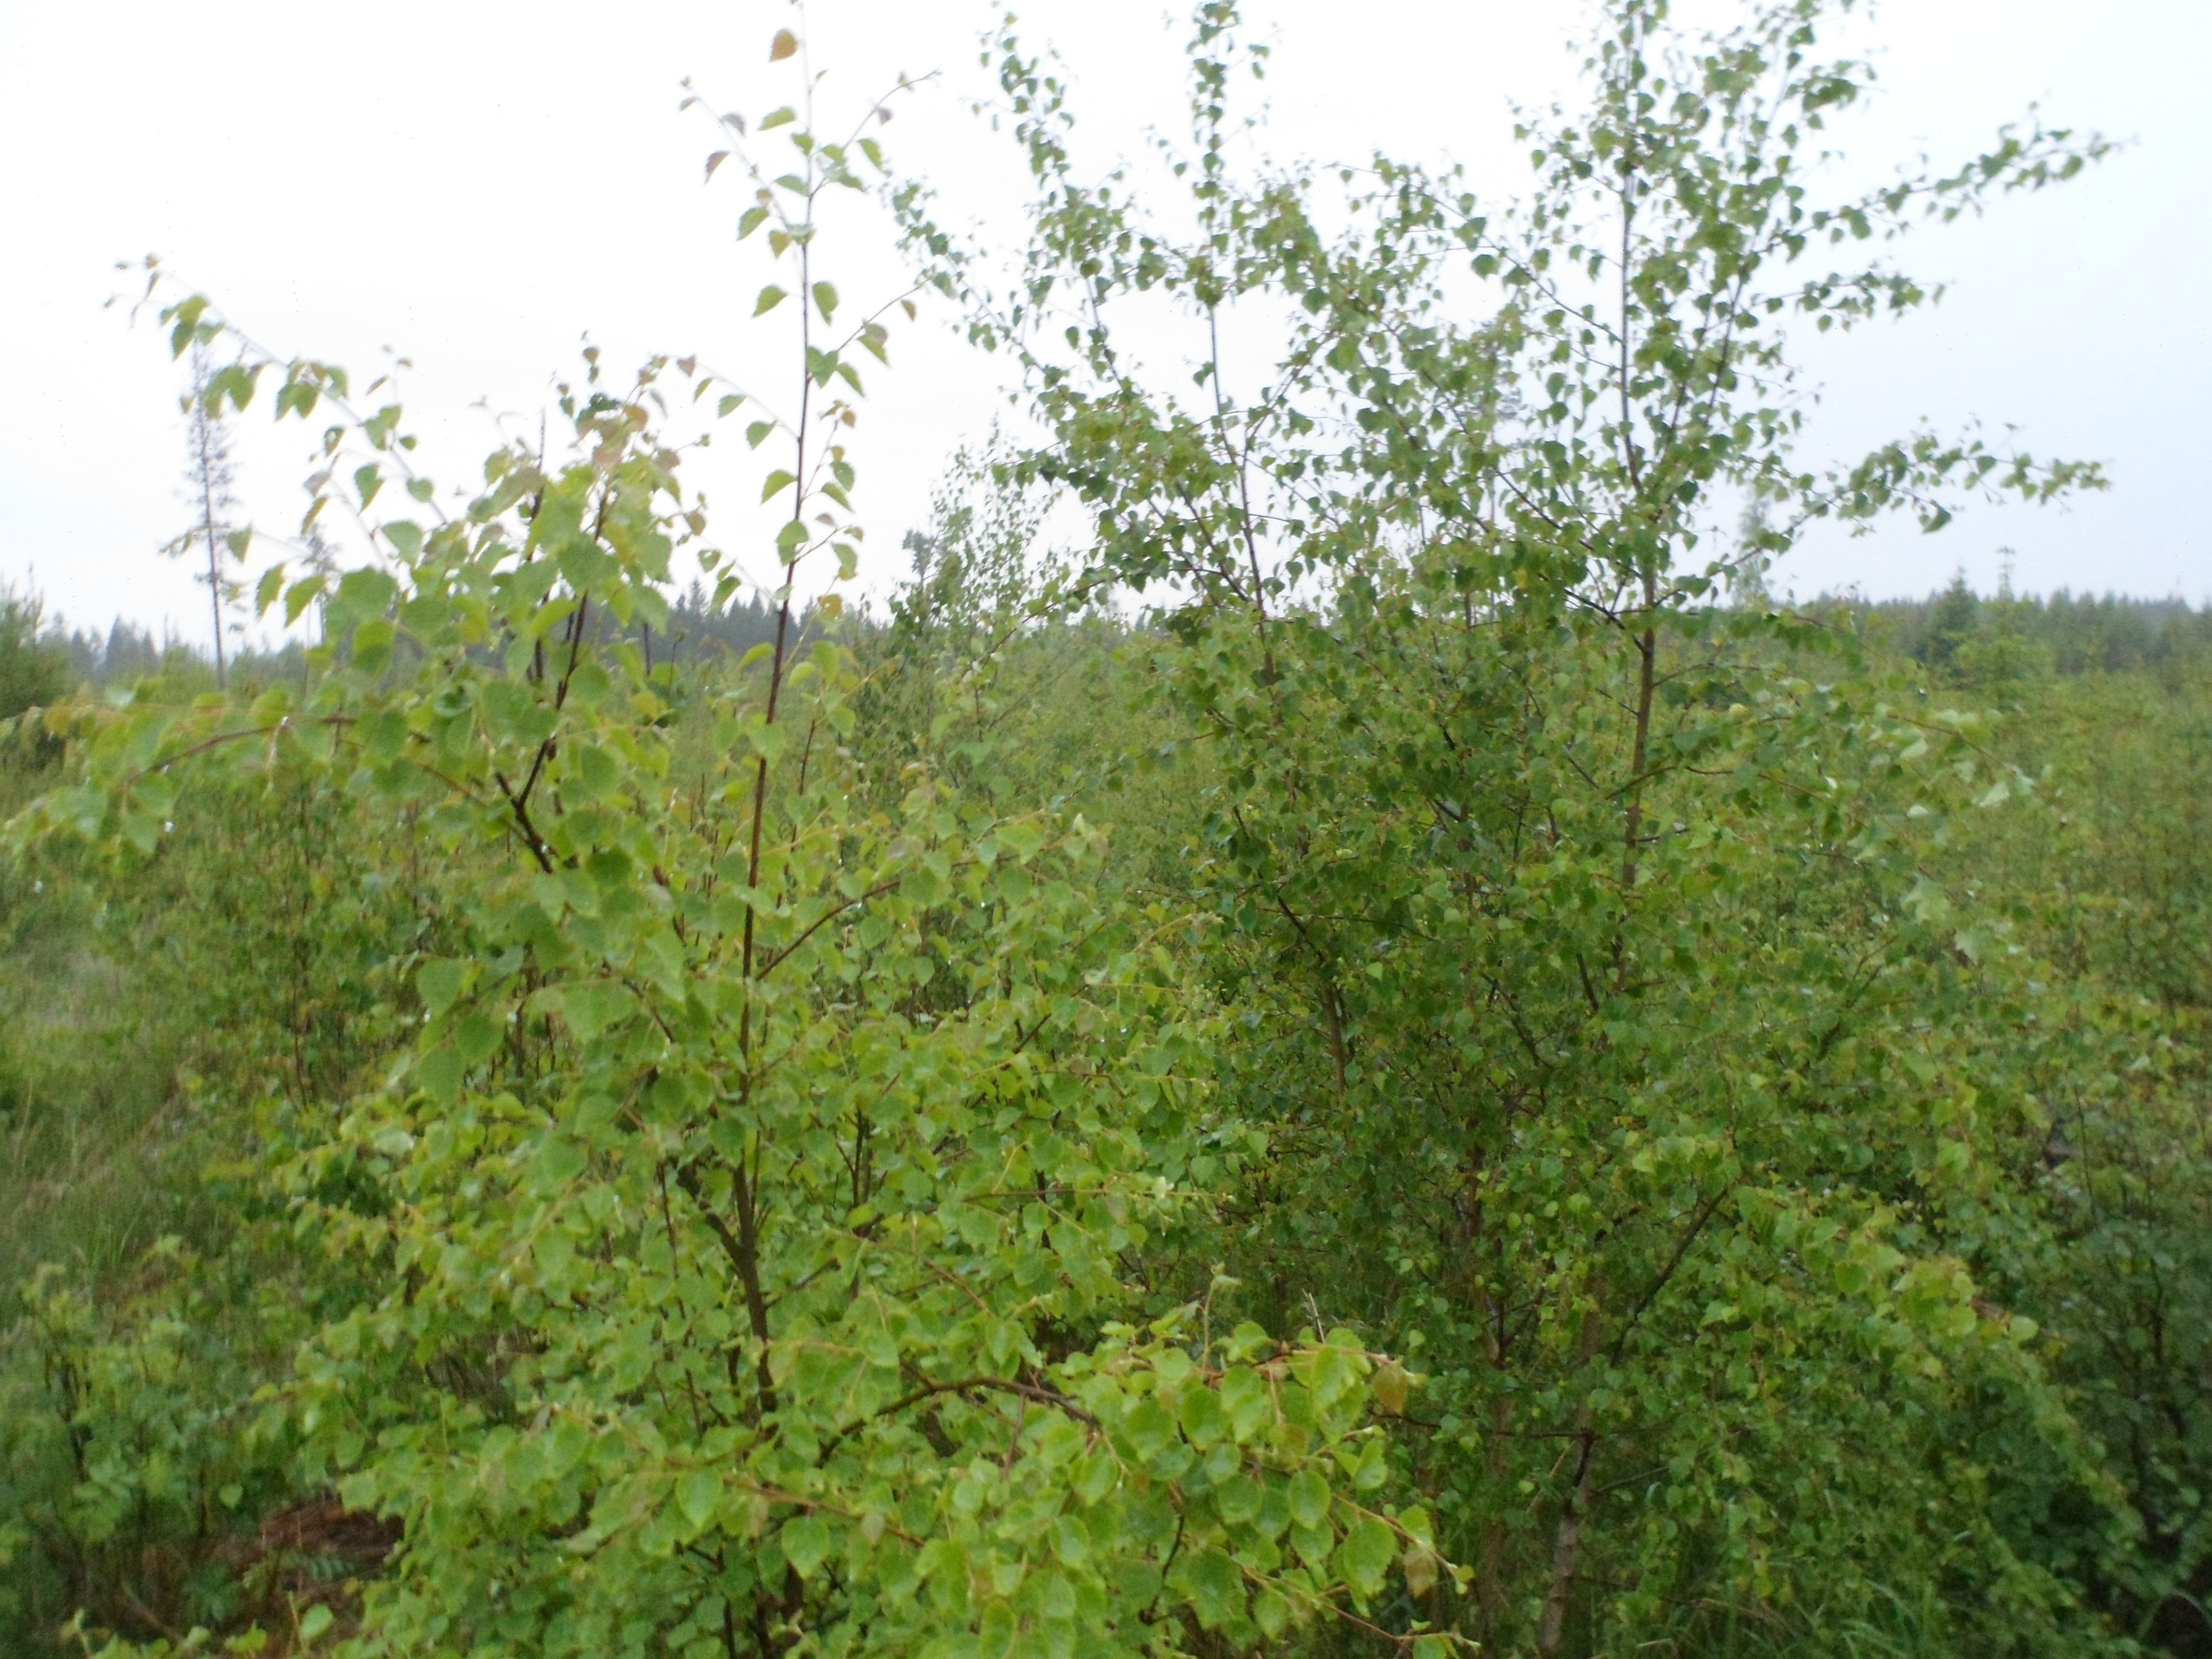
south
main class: Woodland
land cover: Broadleaved woodland
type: boreal forest
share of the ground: 50 - 75 %
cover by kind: broadleaved forest trees 65 %, herbaceous plants 20 %, shrubs 10 %, coniferous forest trees 5 %
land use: Forestry
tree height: > 5 m
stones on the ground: < 10 %
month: June
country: SE
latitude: 57.6316
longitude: 14.1989
